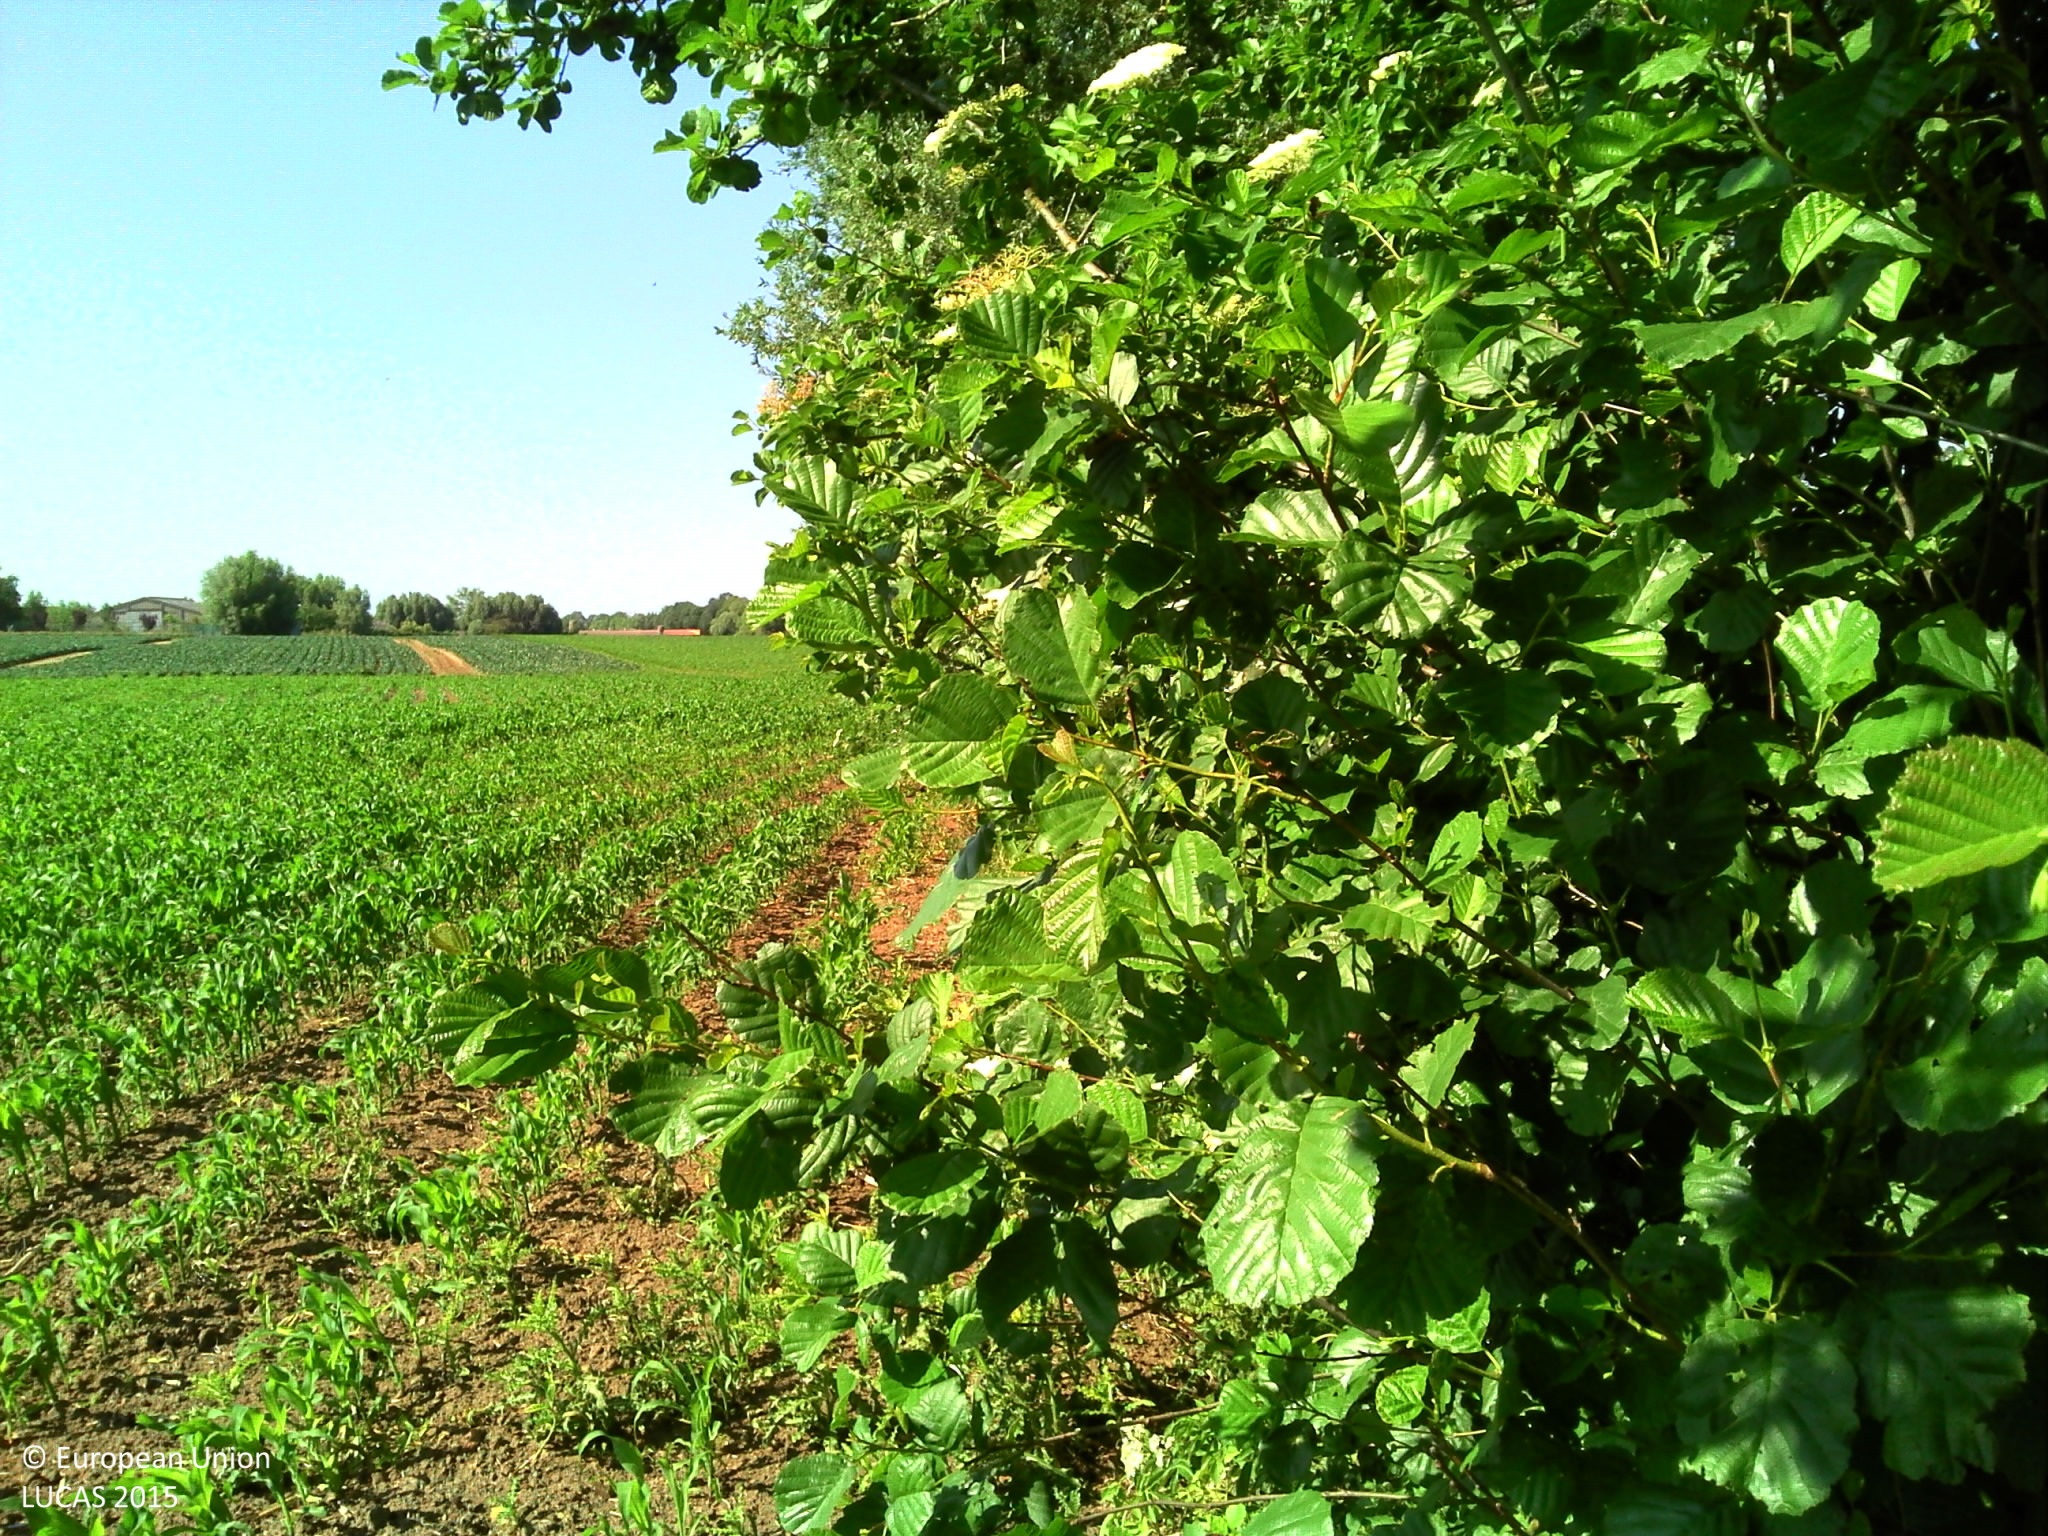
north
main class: Cropland
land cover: Maize
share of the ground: 50 - 75 %
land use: Agriculture (excluding fallow land and kitchen gardens)
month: June
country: BE
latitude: 50.8815
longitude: 2.8683
